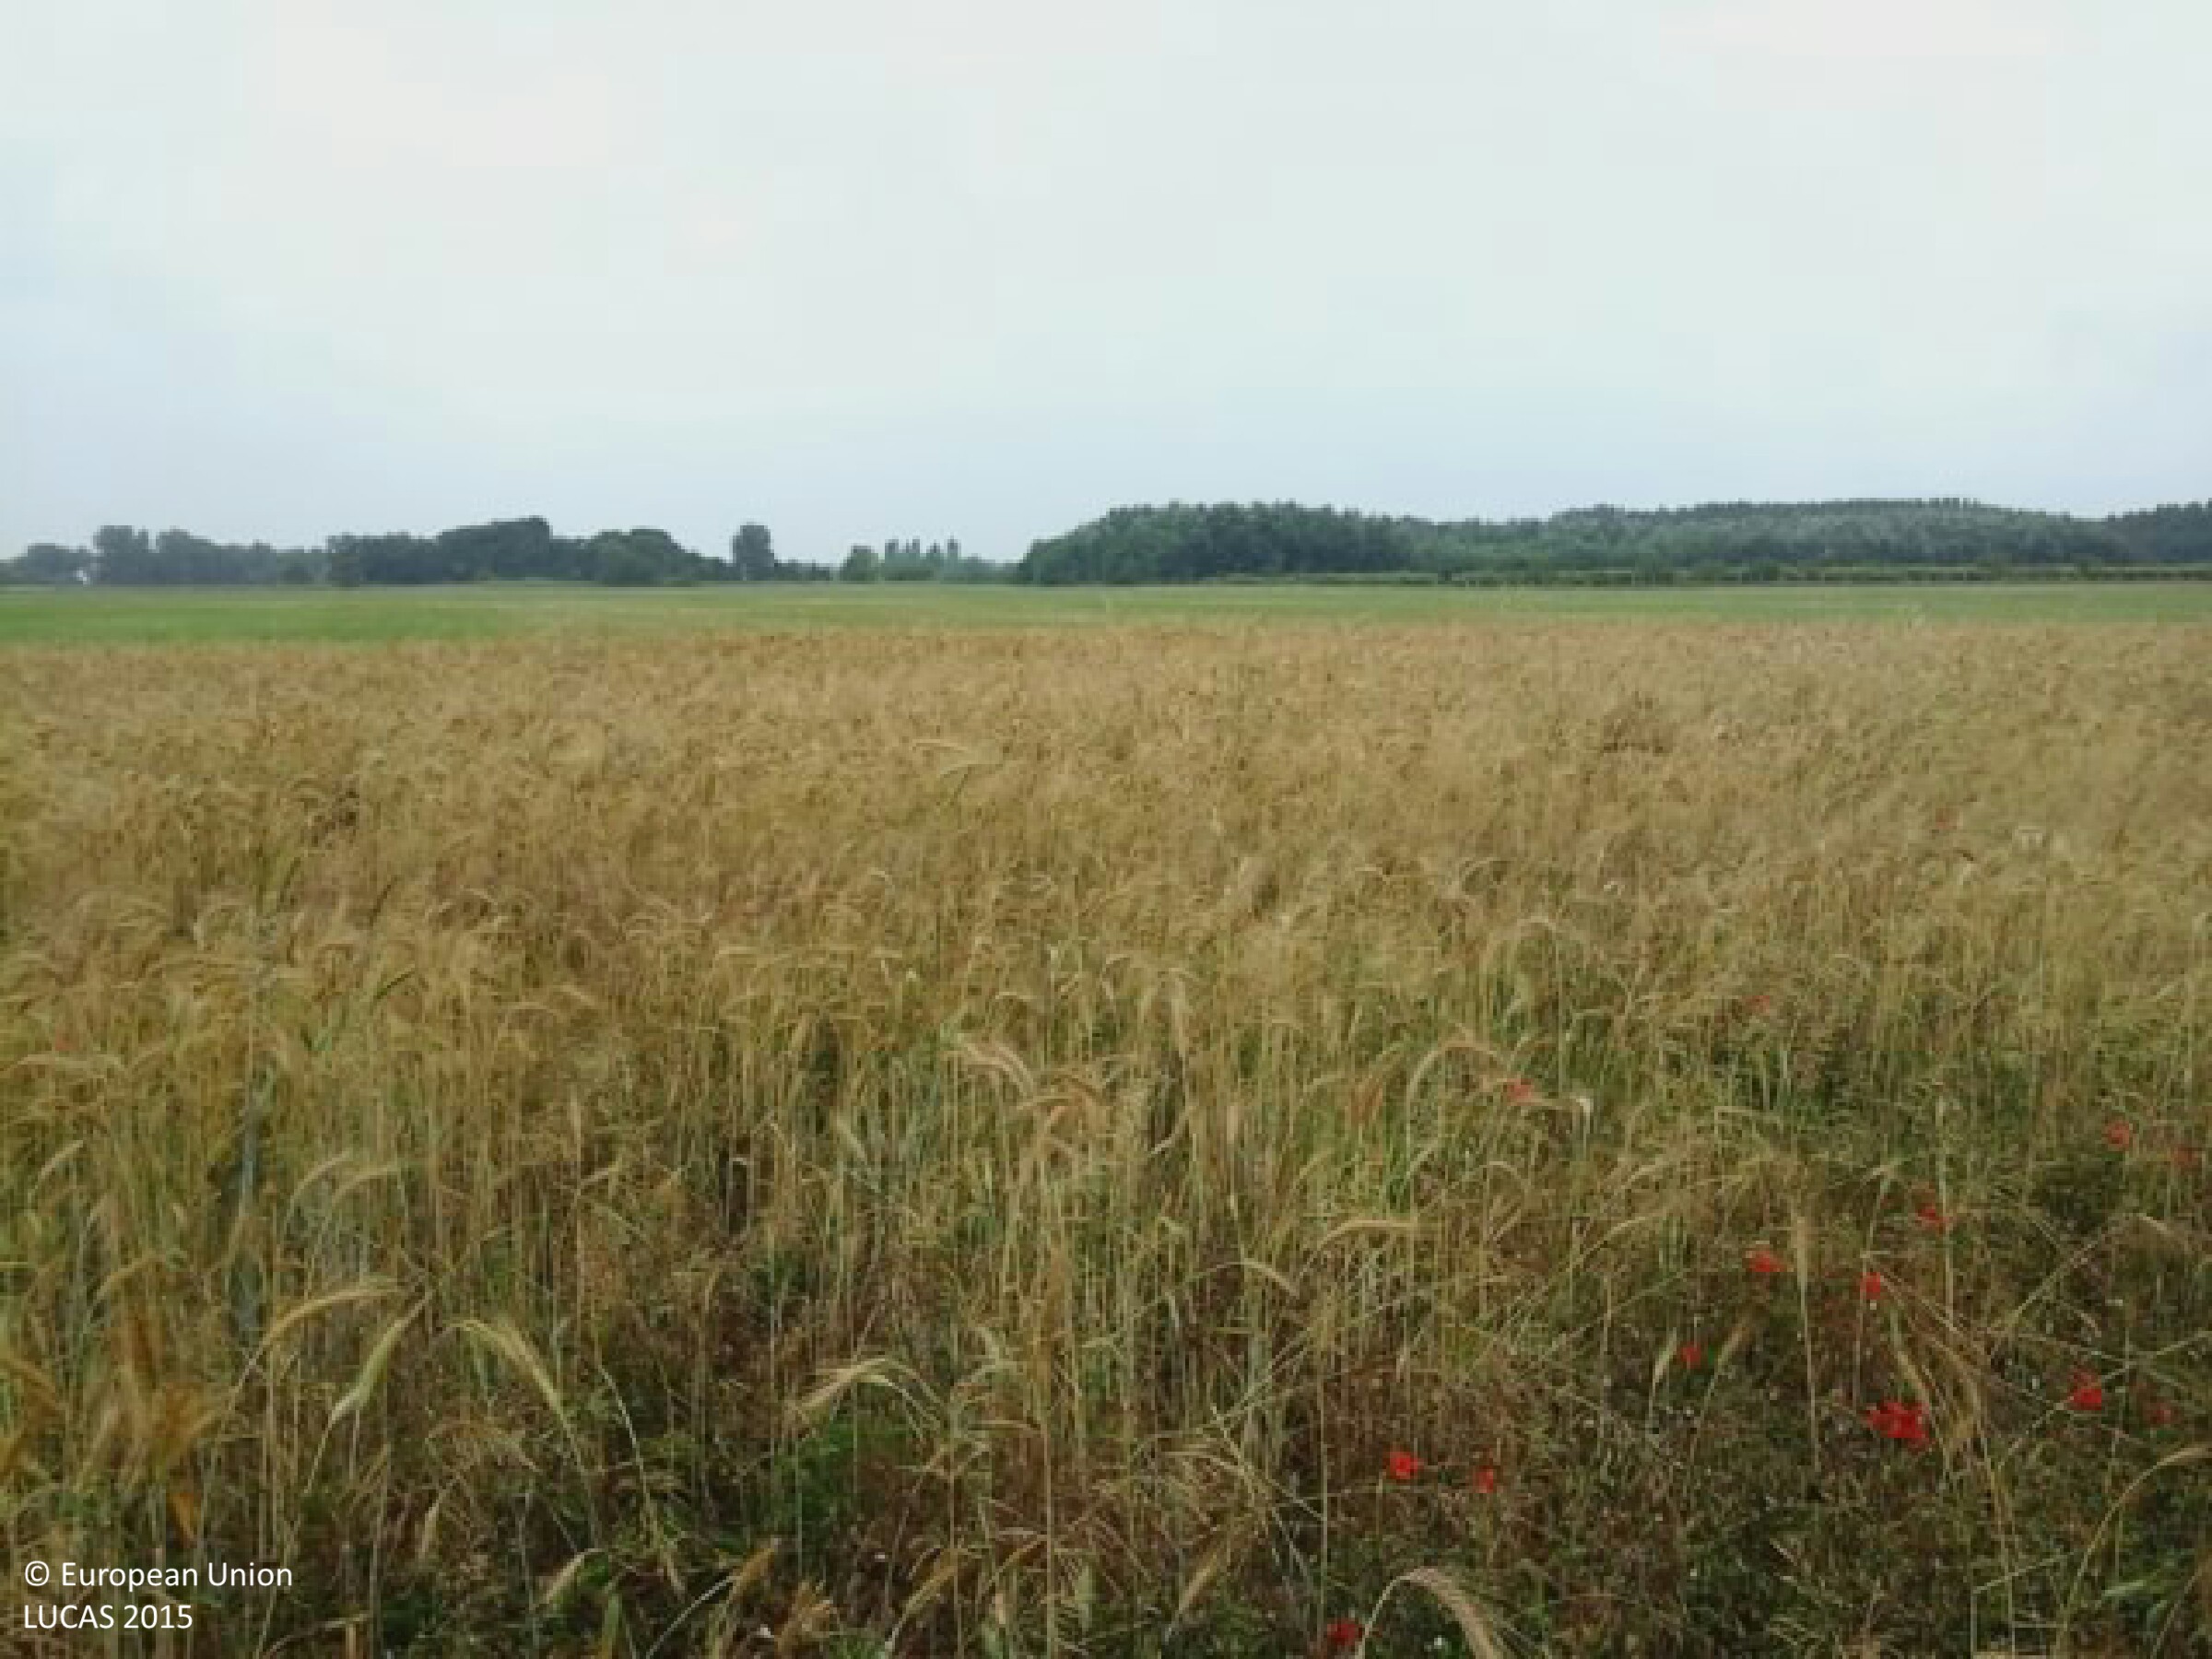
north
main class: Cropland
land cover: Common wheat
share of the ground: > 75 %
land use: Agriculture (excluding fallow land and kitchen gardens)
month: June
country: HU
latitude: 46.3980
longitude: 20.1018
